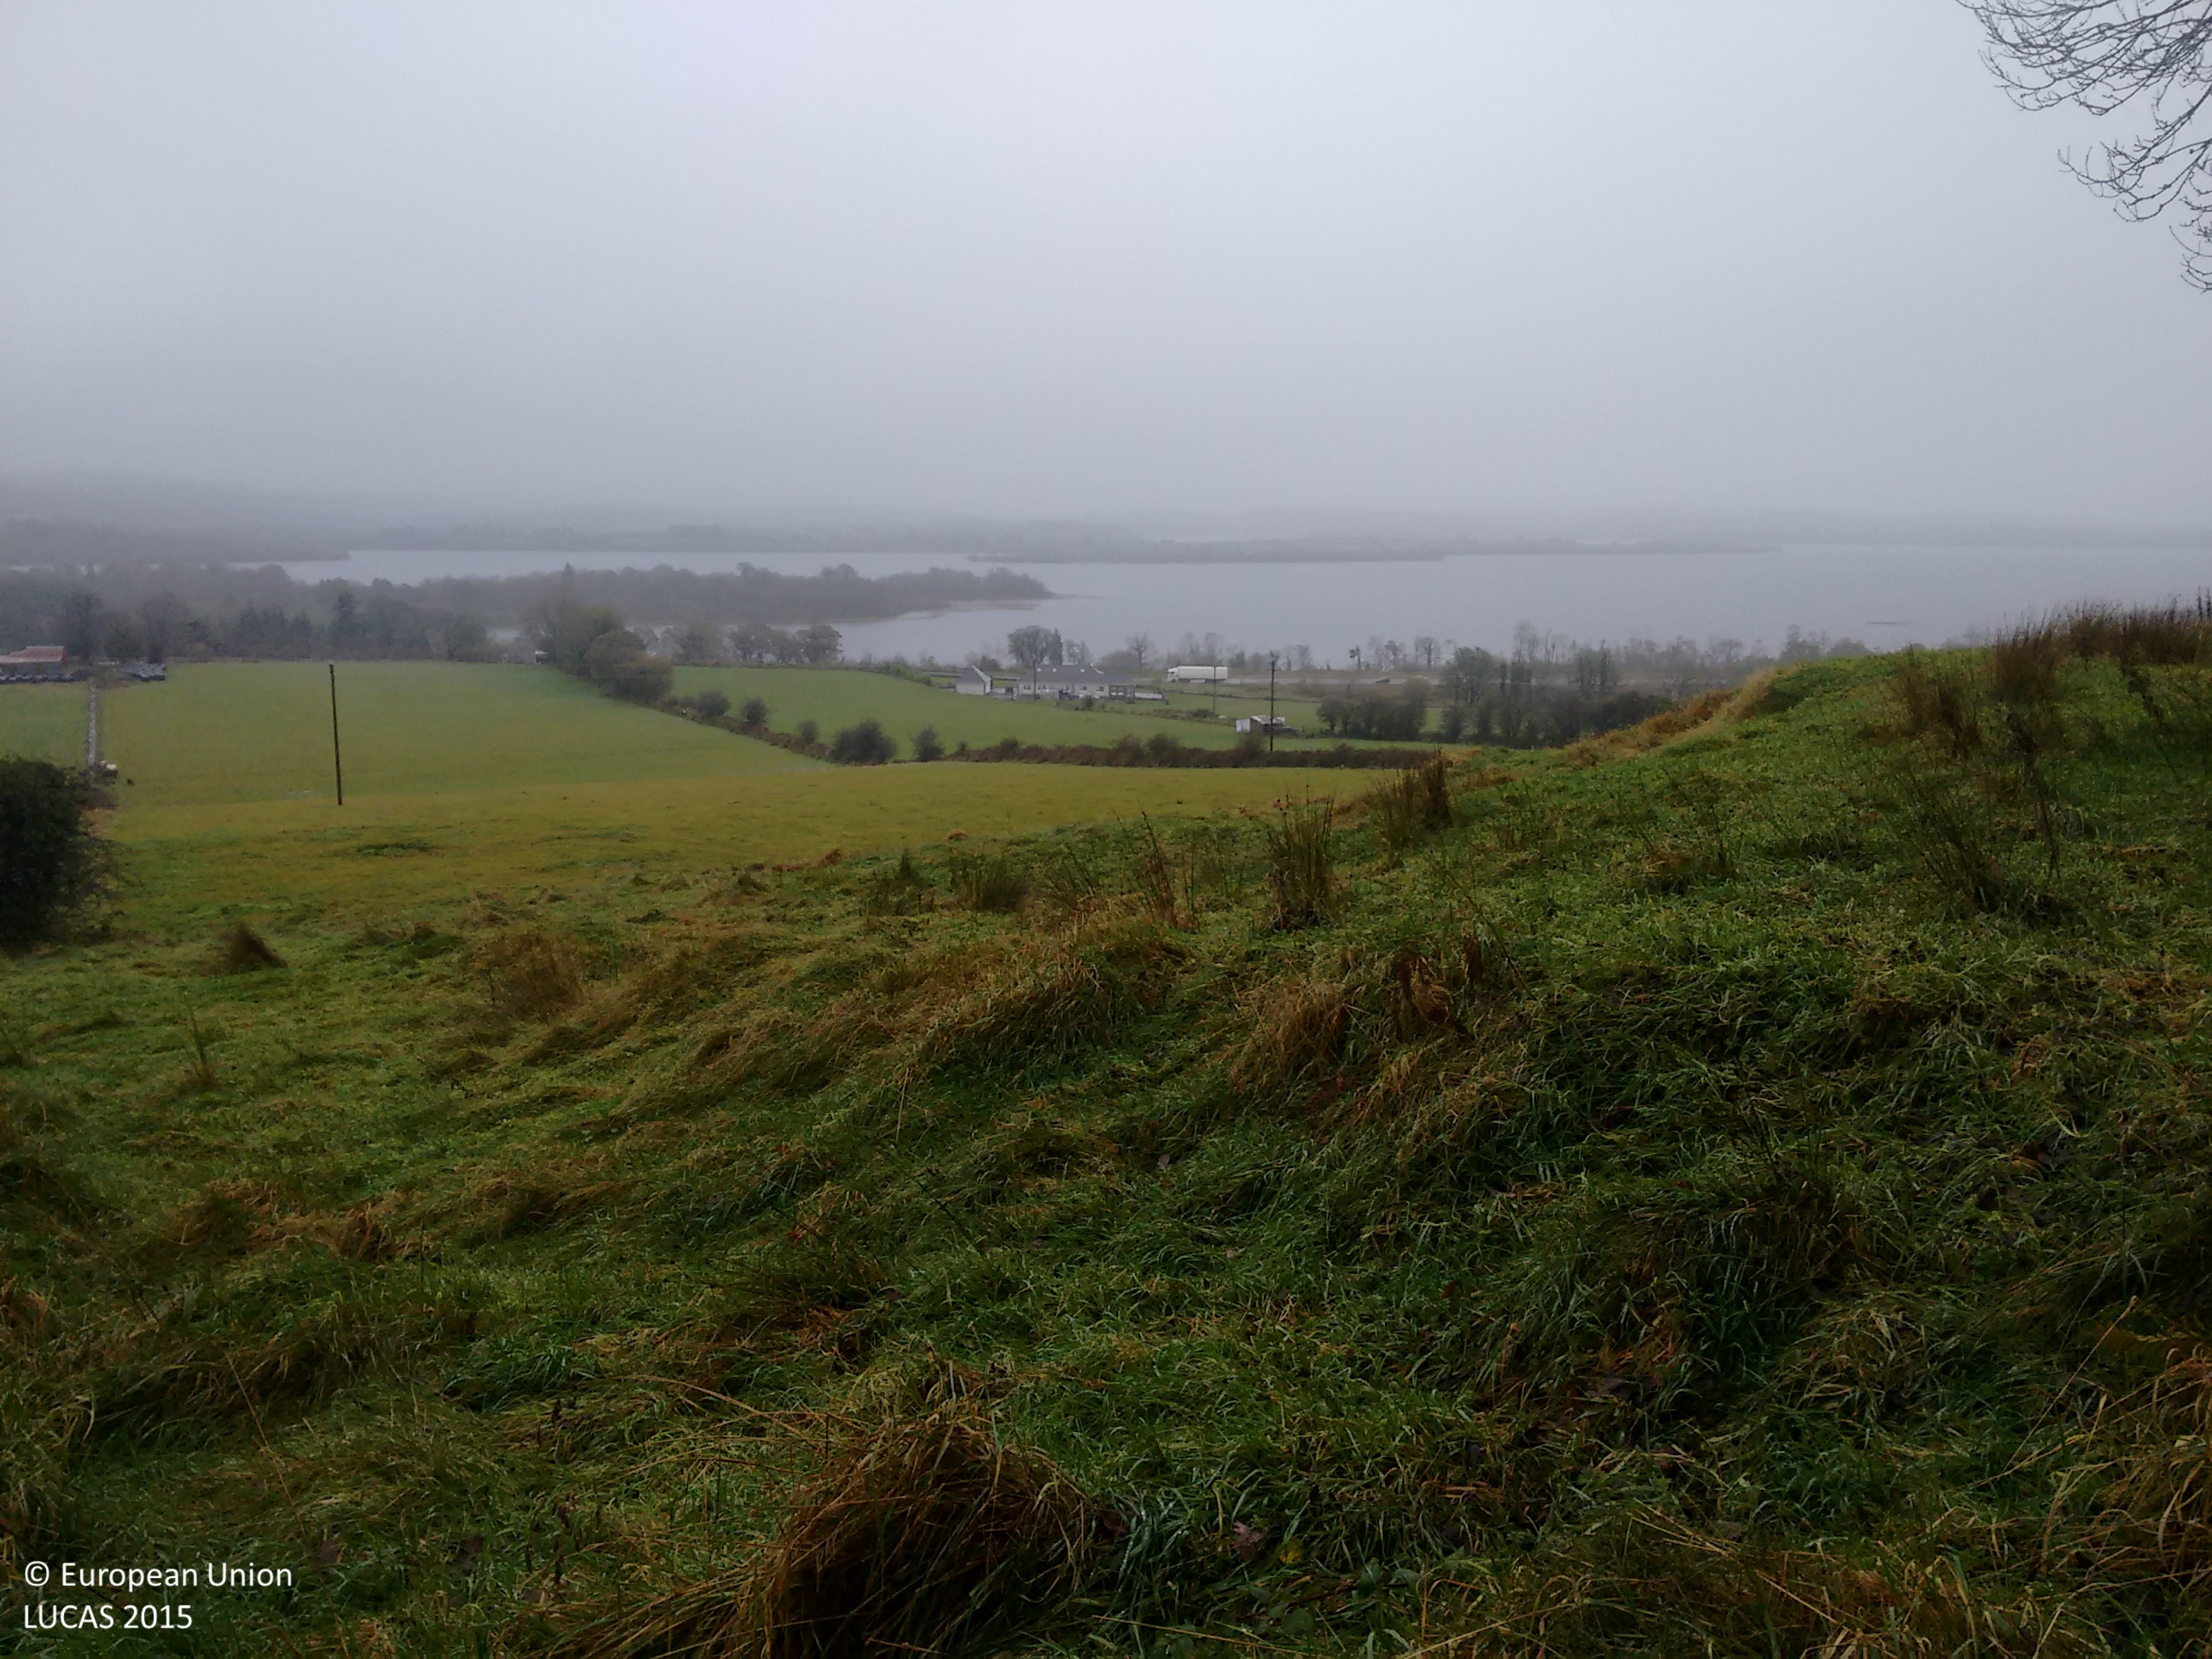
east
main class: Woodland
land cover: Broadleaved woodland
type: exotic forest
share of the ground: > 75 %
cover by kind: broadleaved forest trees 50 %, shrubs 40 %, herbaceous plants 10 %
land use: Agriculture (excluding fallow land and kitchen gardens)
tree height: > 5 m
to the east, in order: Broadleaved woodland; Fences; Grassland without tree/shrub cover; Fences; Dry stone walls; Grassland without tree/shrub cover; Electric lines; Grassland without tree/shrub cover; Fences; Abandoned hedges; Fences; Grassland without tree/shrub cover
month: November
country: IE
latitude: 54.0513
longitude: -8.3479
